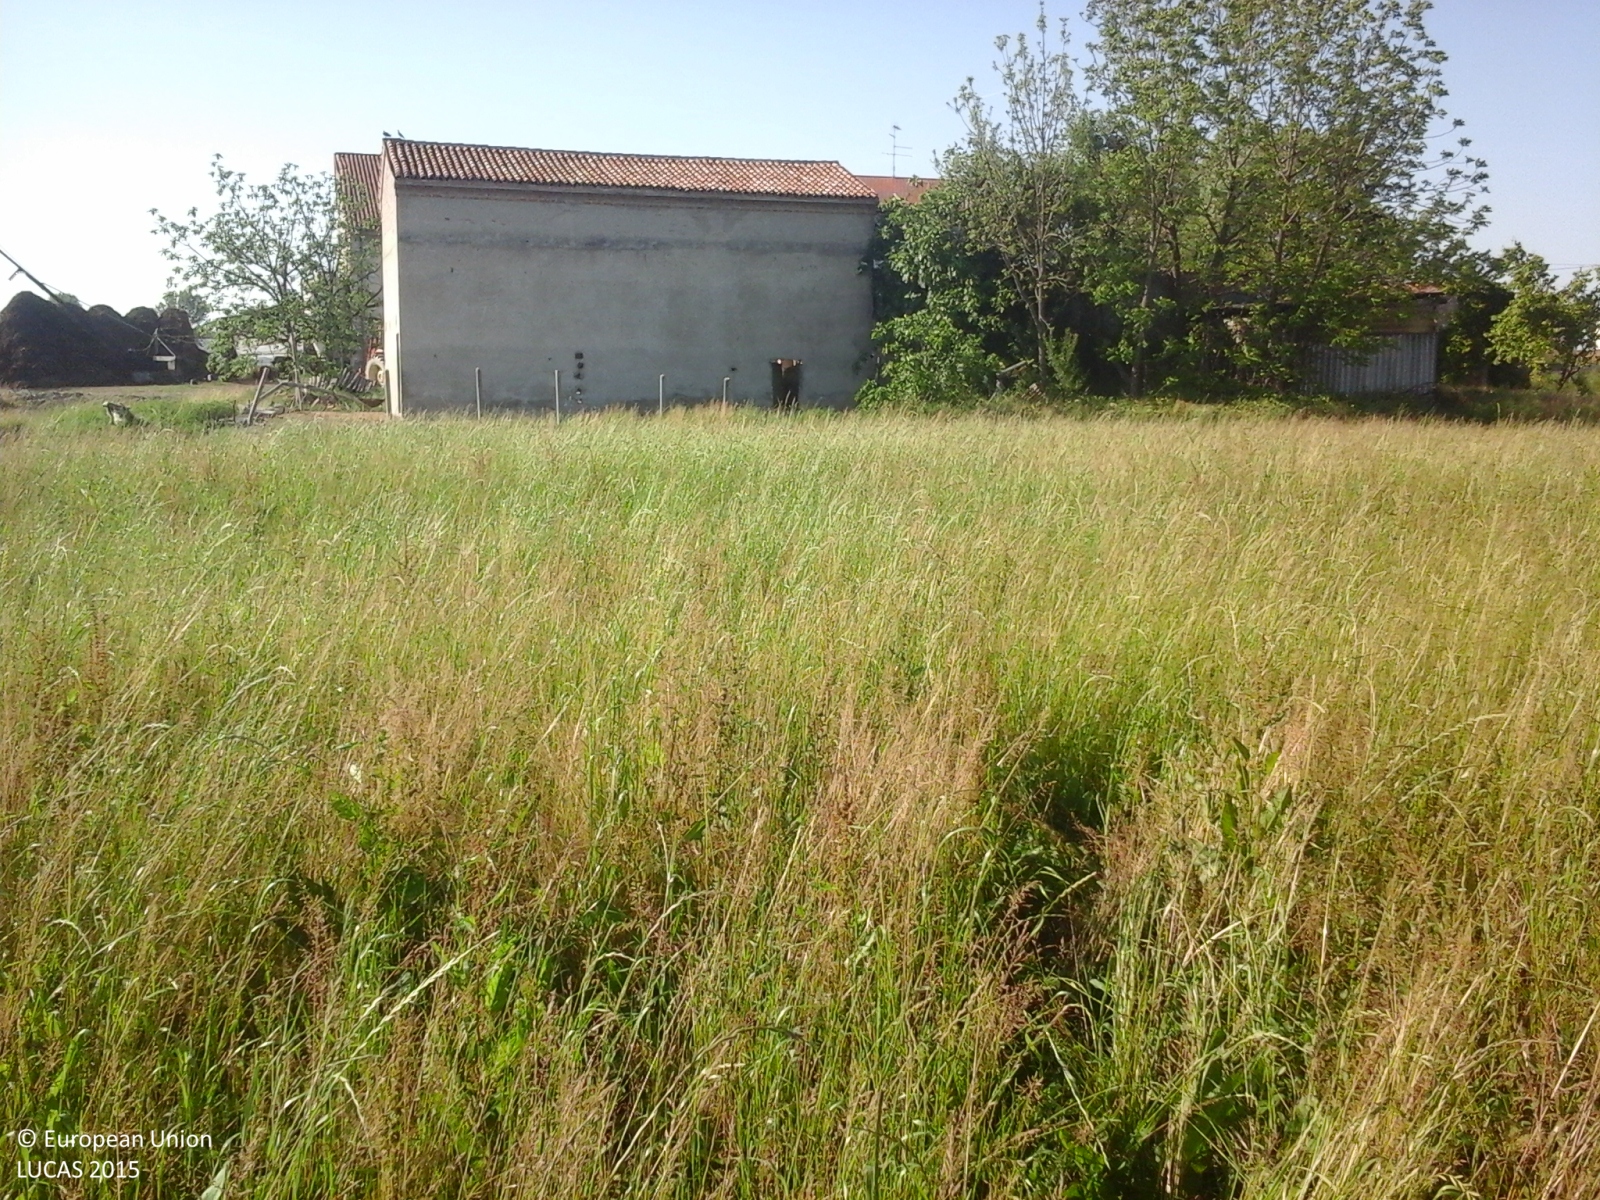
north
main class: Cropland
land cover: Temporary grasslands
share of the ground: > 75 %
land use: Agriculture (excluding fallow land and kitchen gardens)
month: May
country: IT
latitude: 44.9776
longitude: 10.9239
